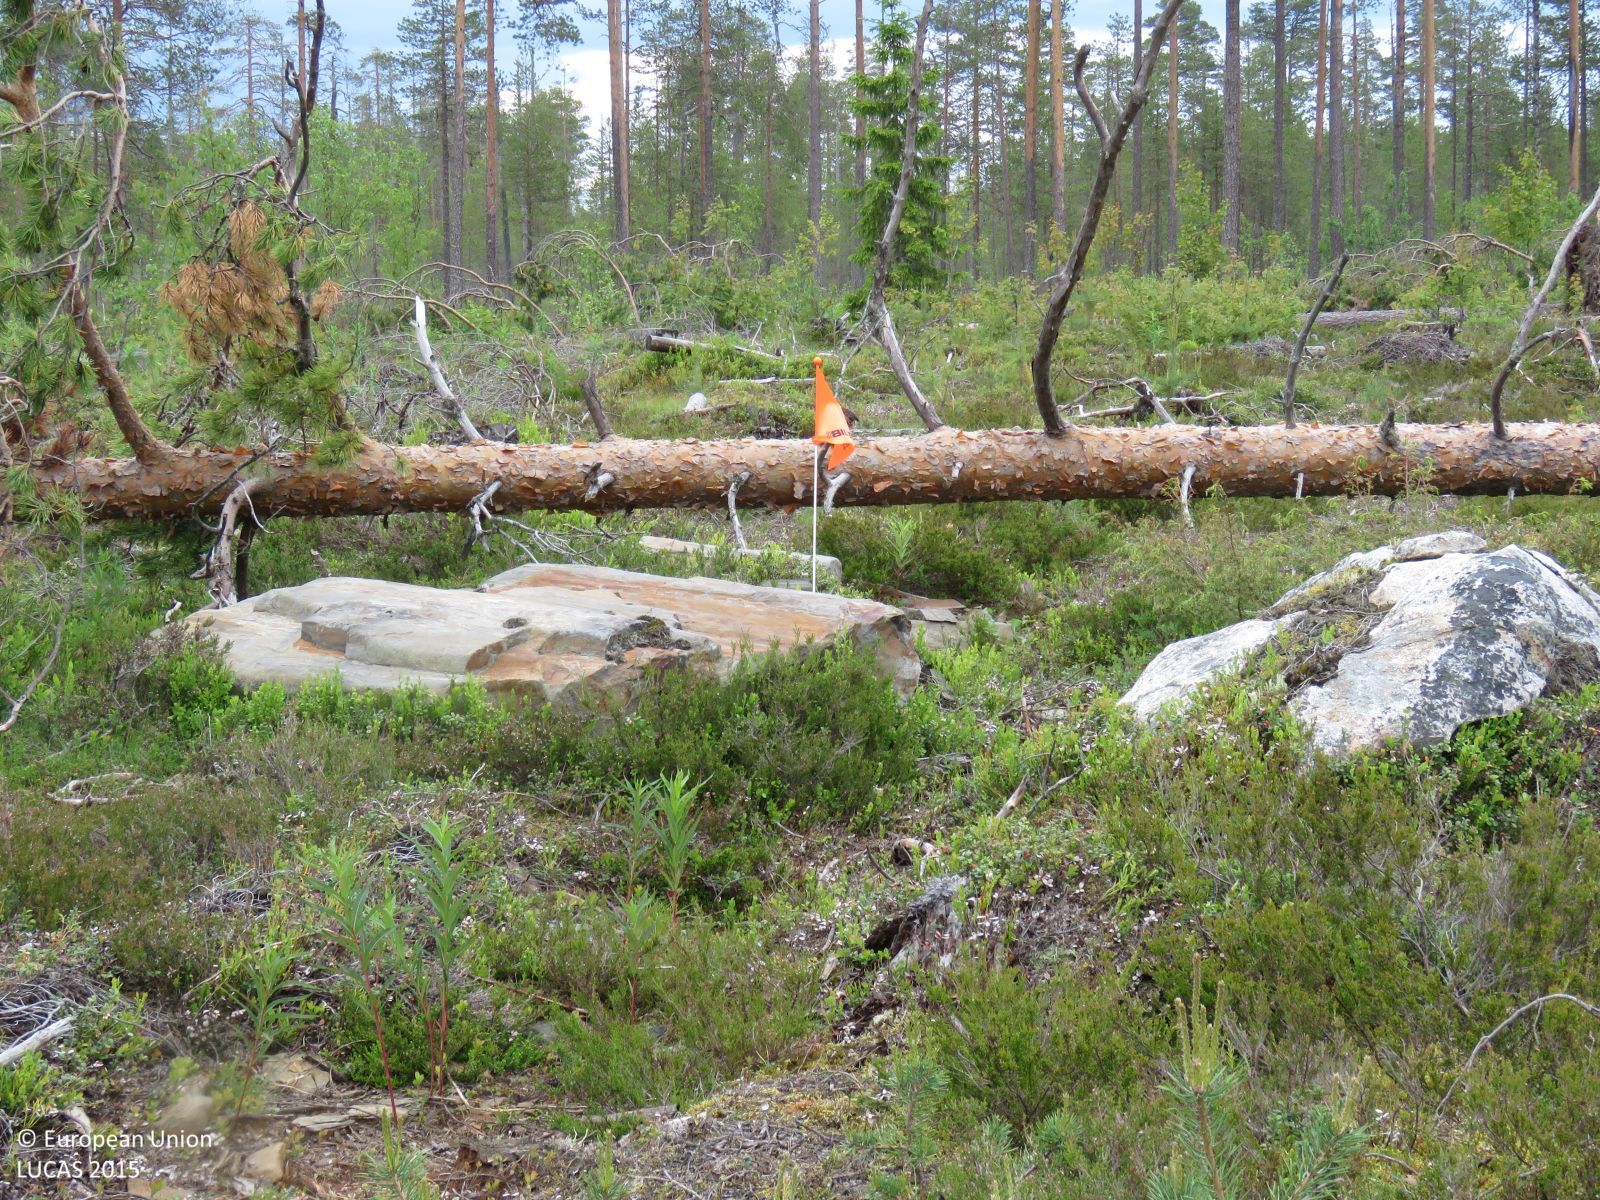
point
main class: Woodland
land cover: Other coniferous woodland
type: boreal forest
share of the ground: 10 - 25 %
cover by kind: shrubs 40 %, herbaceous plants 20 %, coniferous forest trees 15 %, lichens and mosses 10 %, unconsolidated bare surface 10 %, broadleaved forest trees 5 %
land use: Forestry
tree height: < 5 m
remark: Clear cut
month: June
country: FI
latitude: 64.0861
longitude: 26.8017
